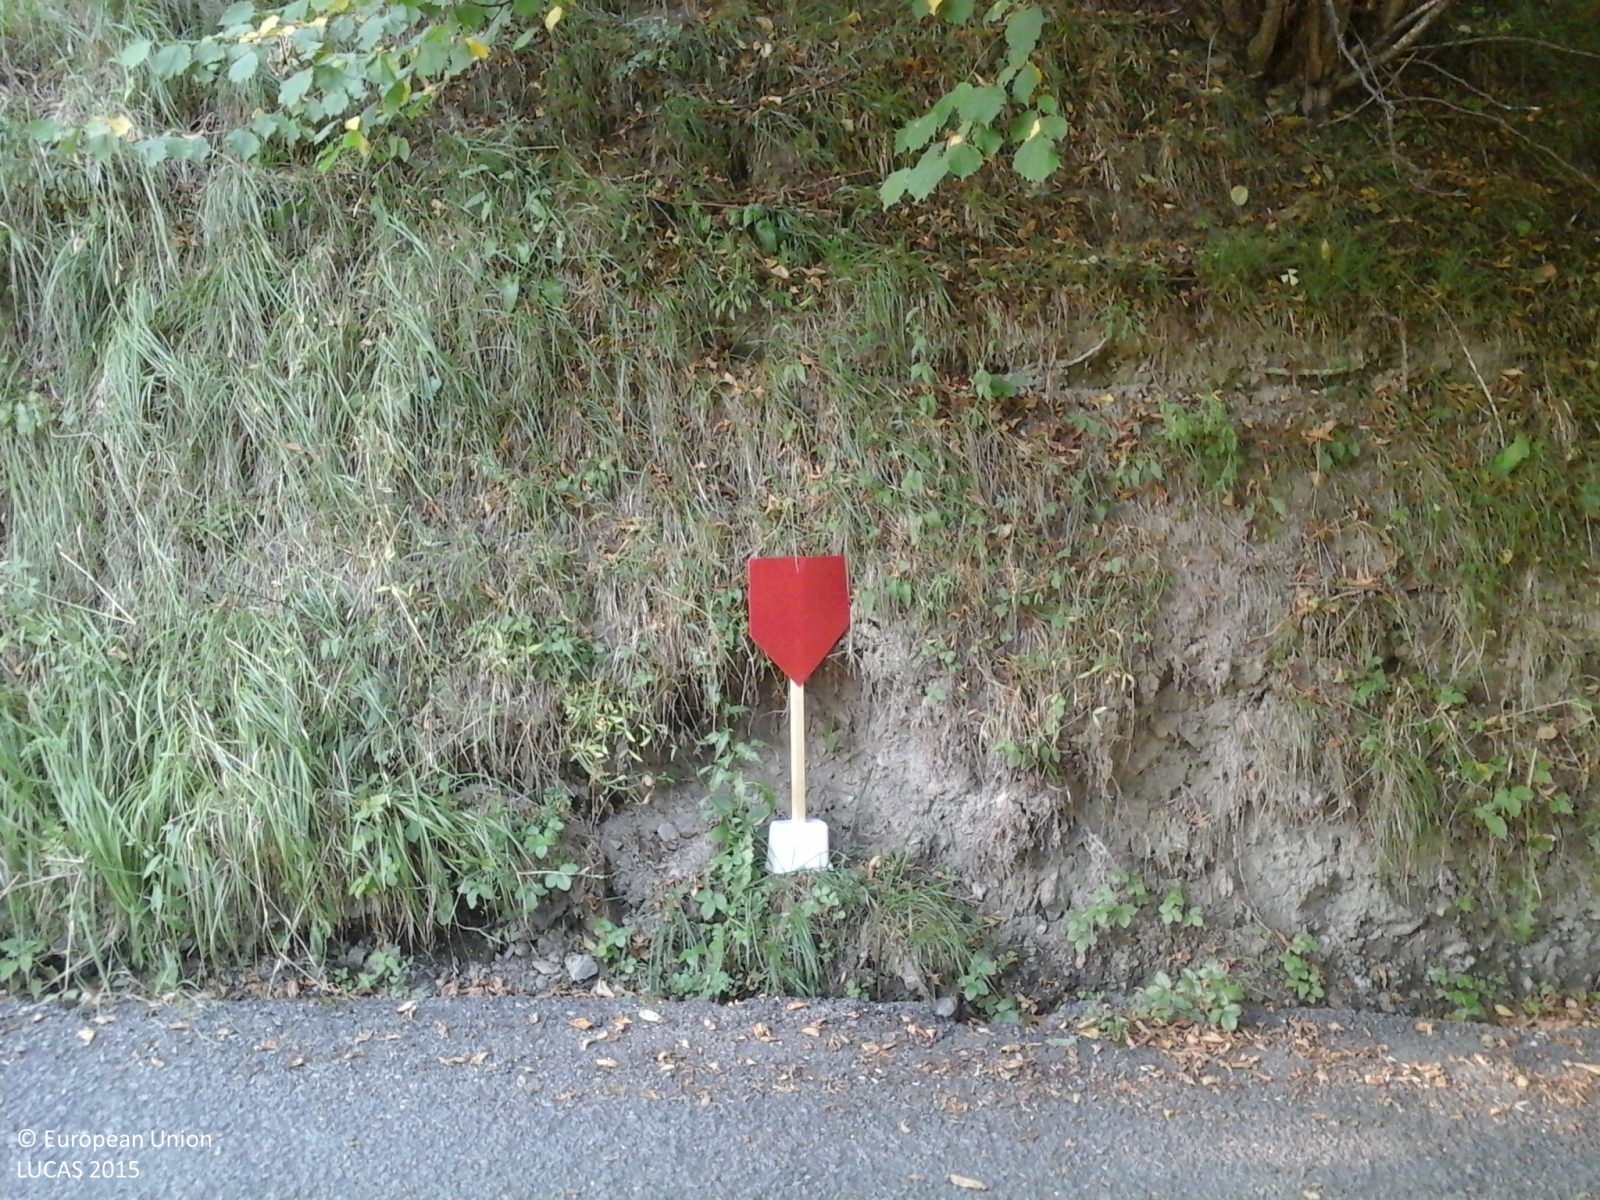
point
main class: Grassland
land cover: Grassland with sparse tree/shrub cover
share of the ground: > 75 %
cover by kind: herbaceous plants 85 %, shrubs 10 %, broadleaved forest trees 5 %
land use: Semi-natural and natural areas not in use
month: August
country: IT
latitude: 44.4035
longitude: 9.5114
